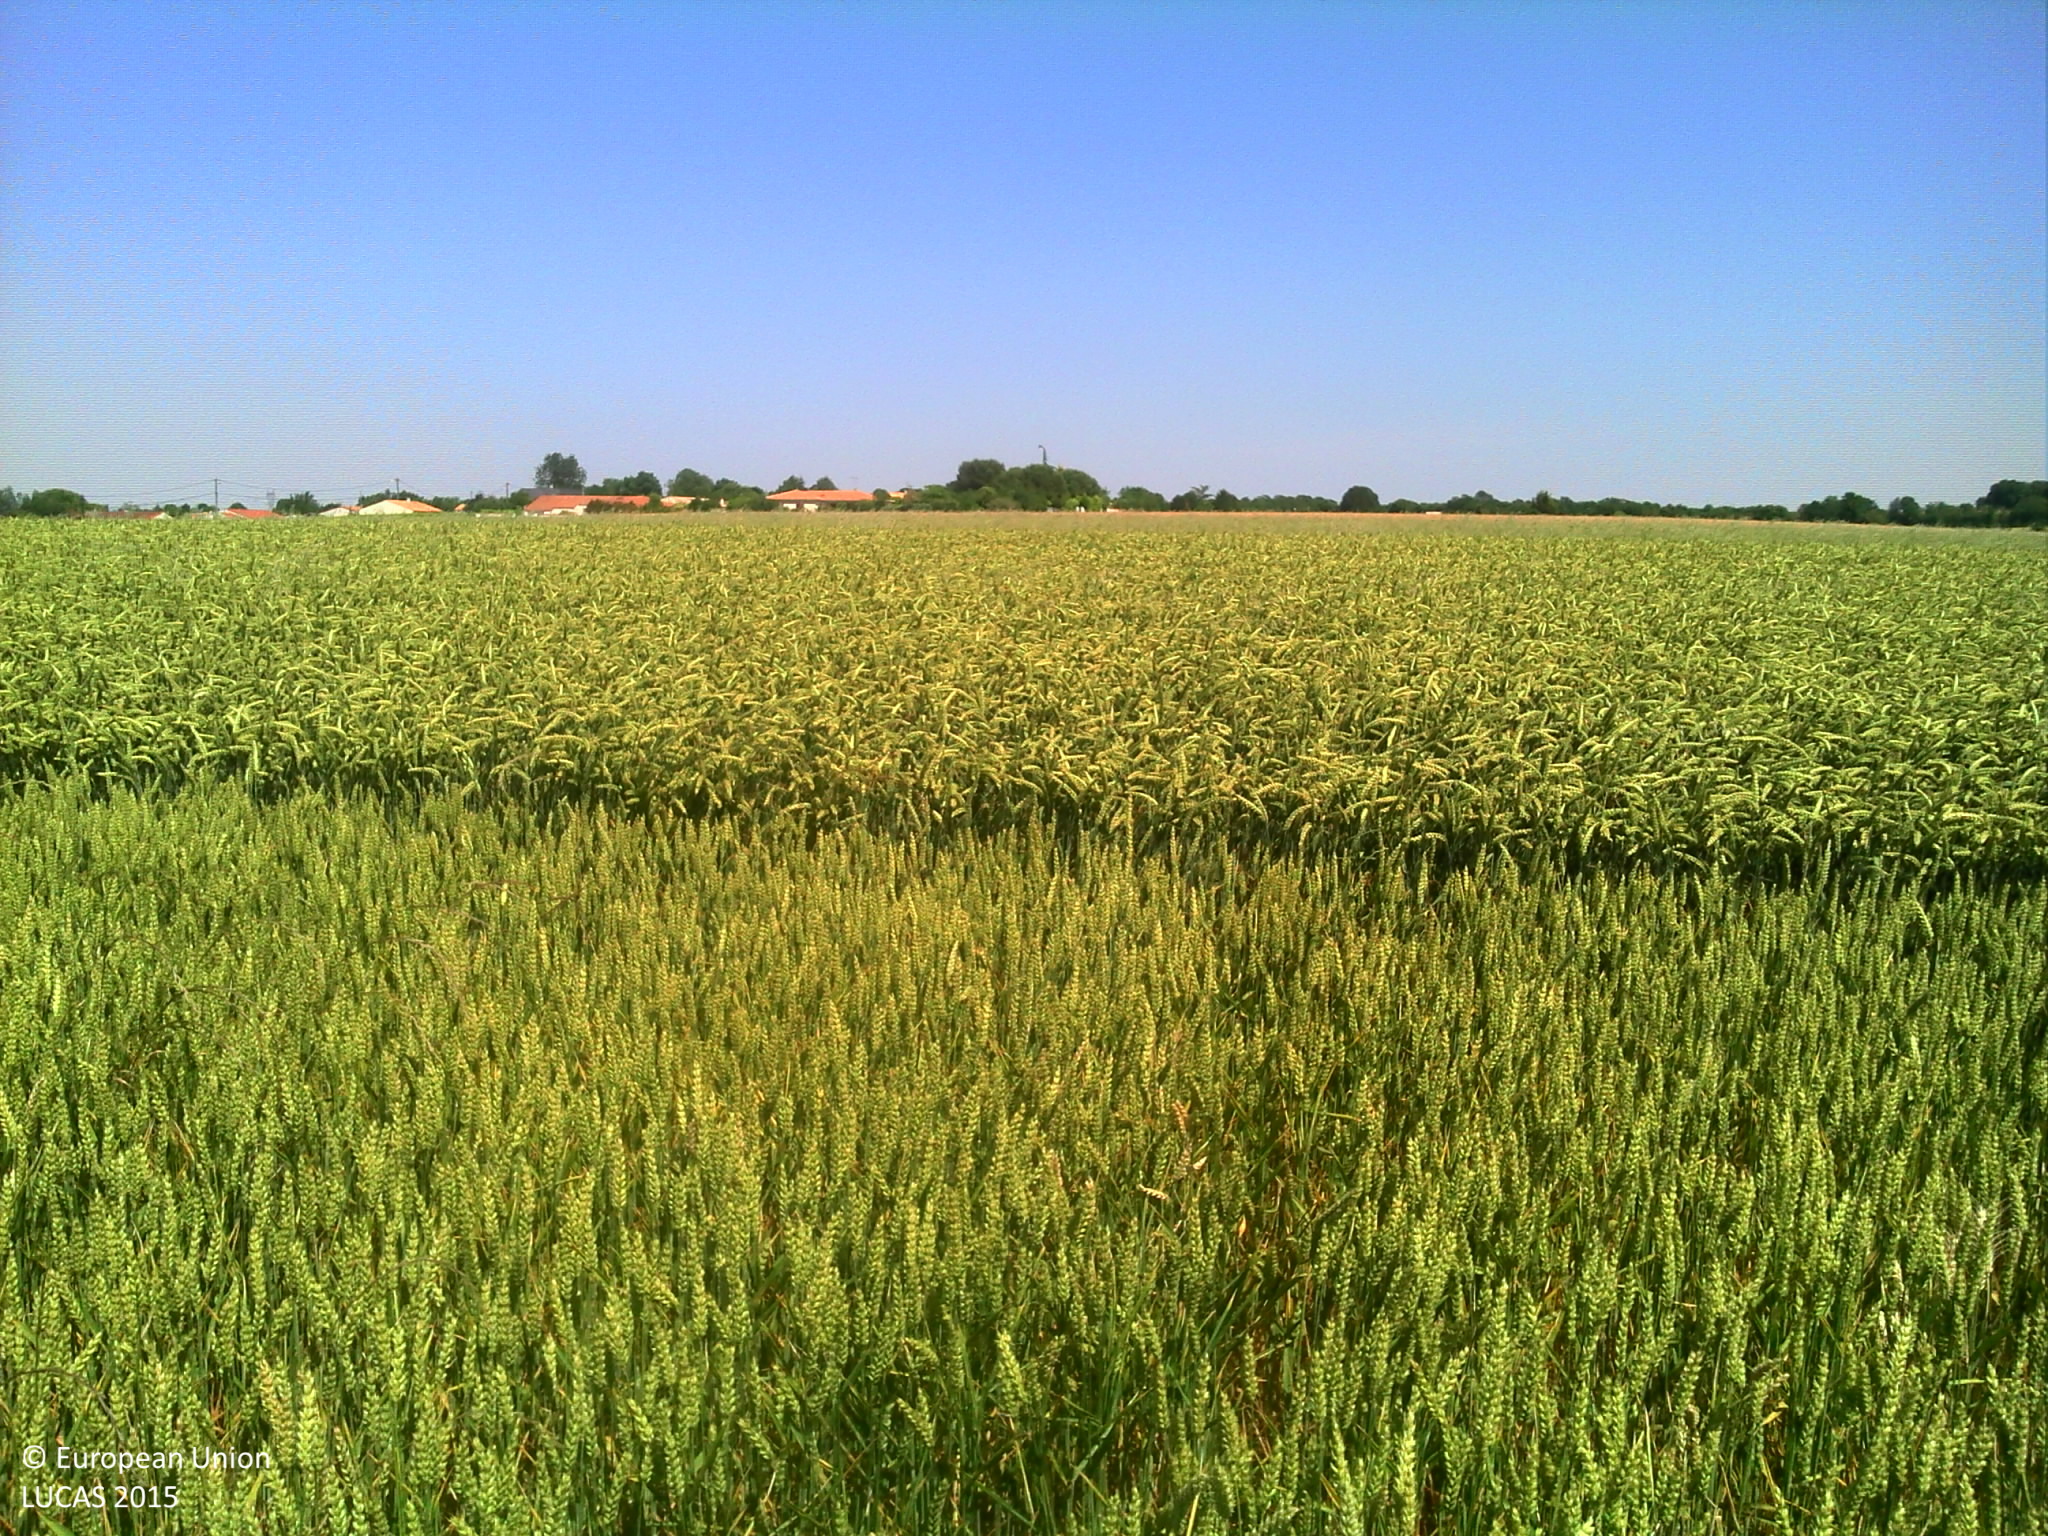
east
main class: Cropland
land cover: Common wheat
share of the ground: > 75 %
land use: Agriculture (excluding fallow land and kitchen gardens)
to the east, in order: Common wheat; Barley
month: June
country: FR
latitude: 46.1077
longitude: -1.0140
